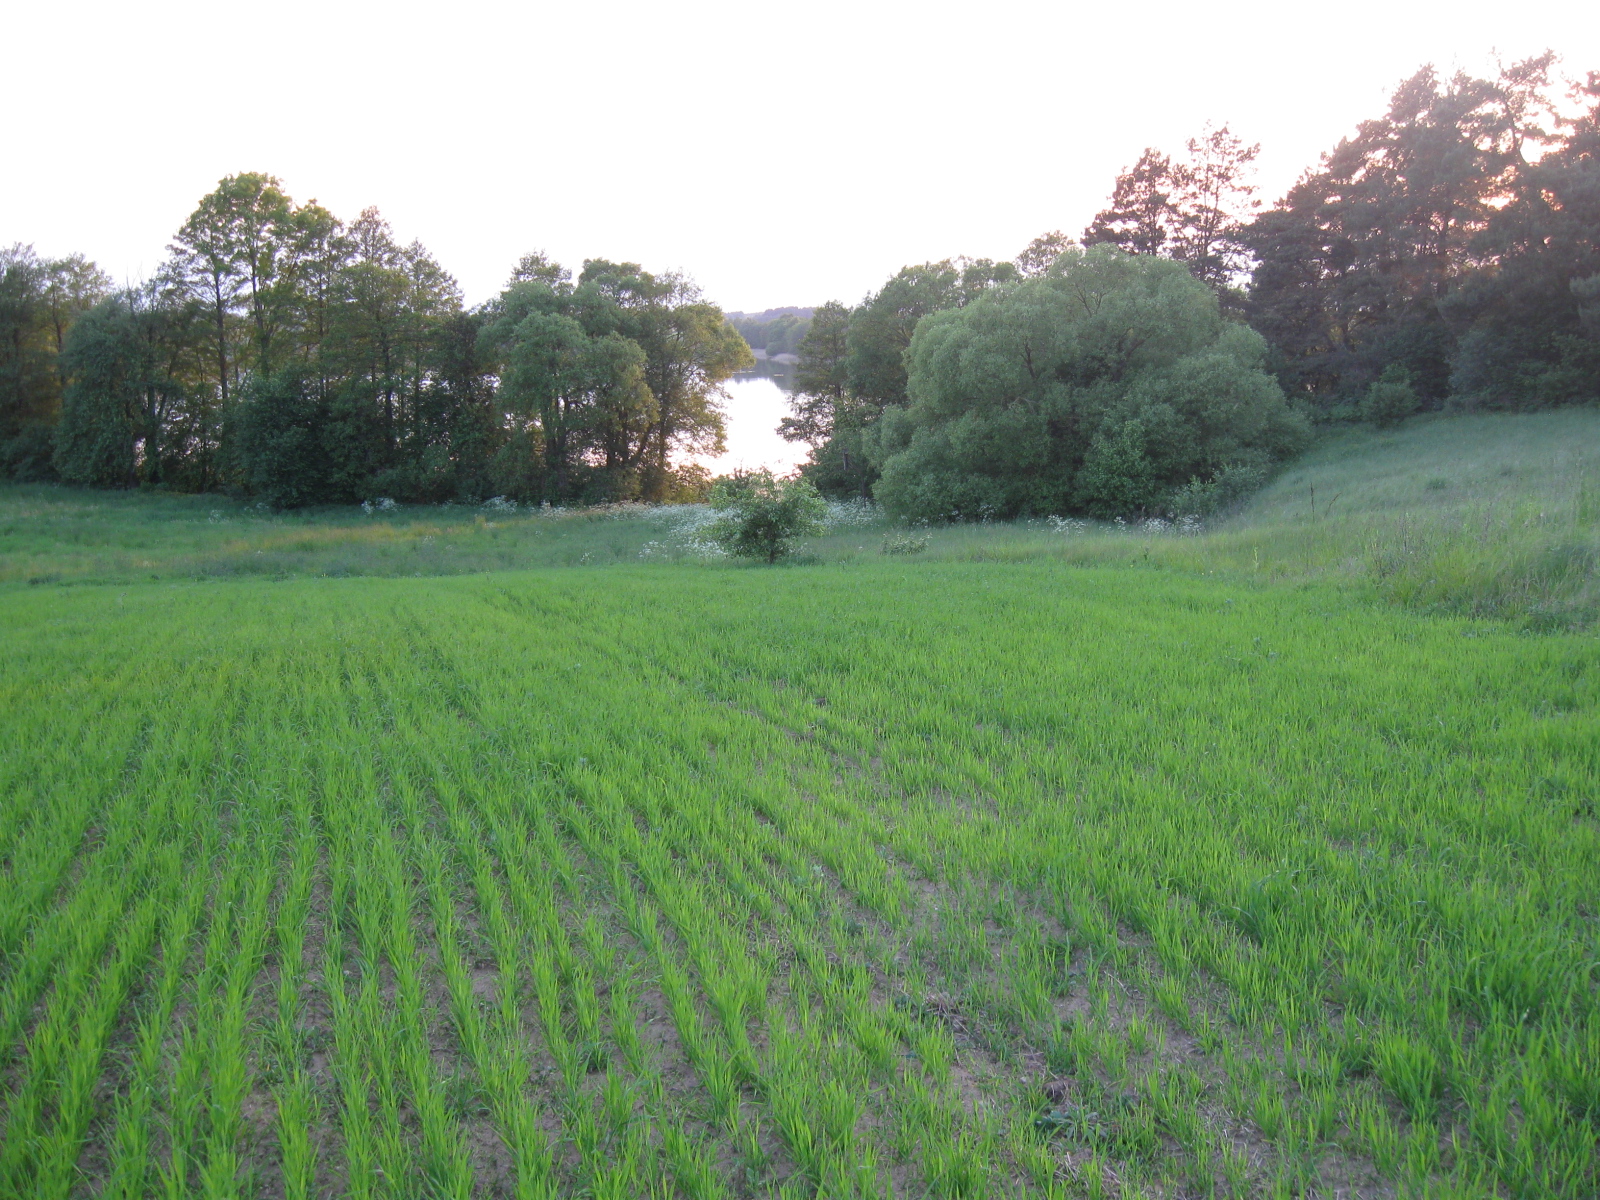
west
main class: Cropland
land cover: Oats
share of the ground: > 75 %
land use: Agriculture (excluding fallow land and kitchen gardens)
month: June
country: LT
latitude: 54.1904
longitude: 23.6800
